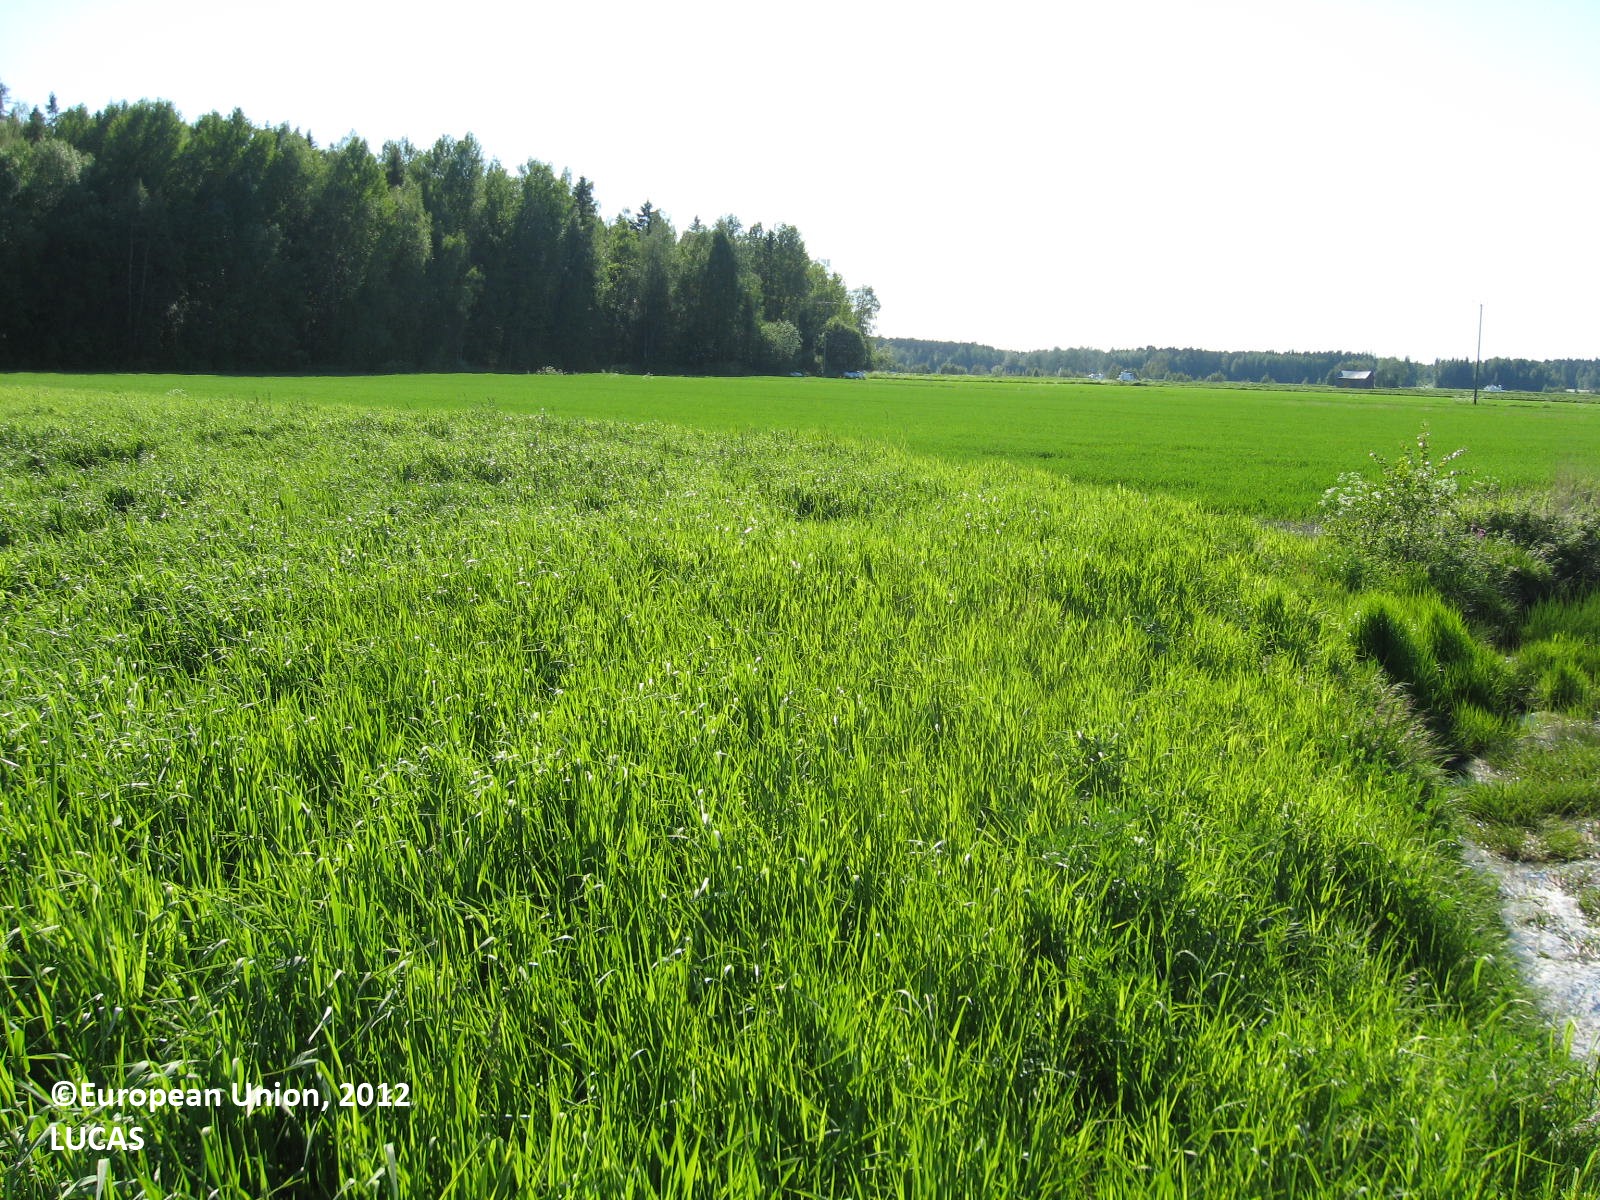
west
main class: Cropland
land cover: Temporary grasslands
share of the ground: > 75 %
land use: Agriculture (excluding fallow land and kitchen gardens)
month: June
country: FI
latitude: 63.0030
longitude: 21.8314
